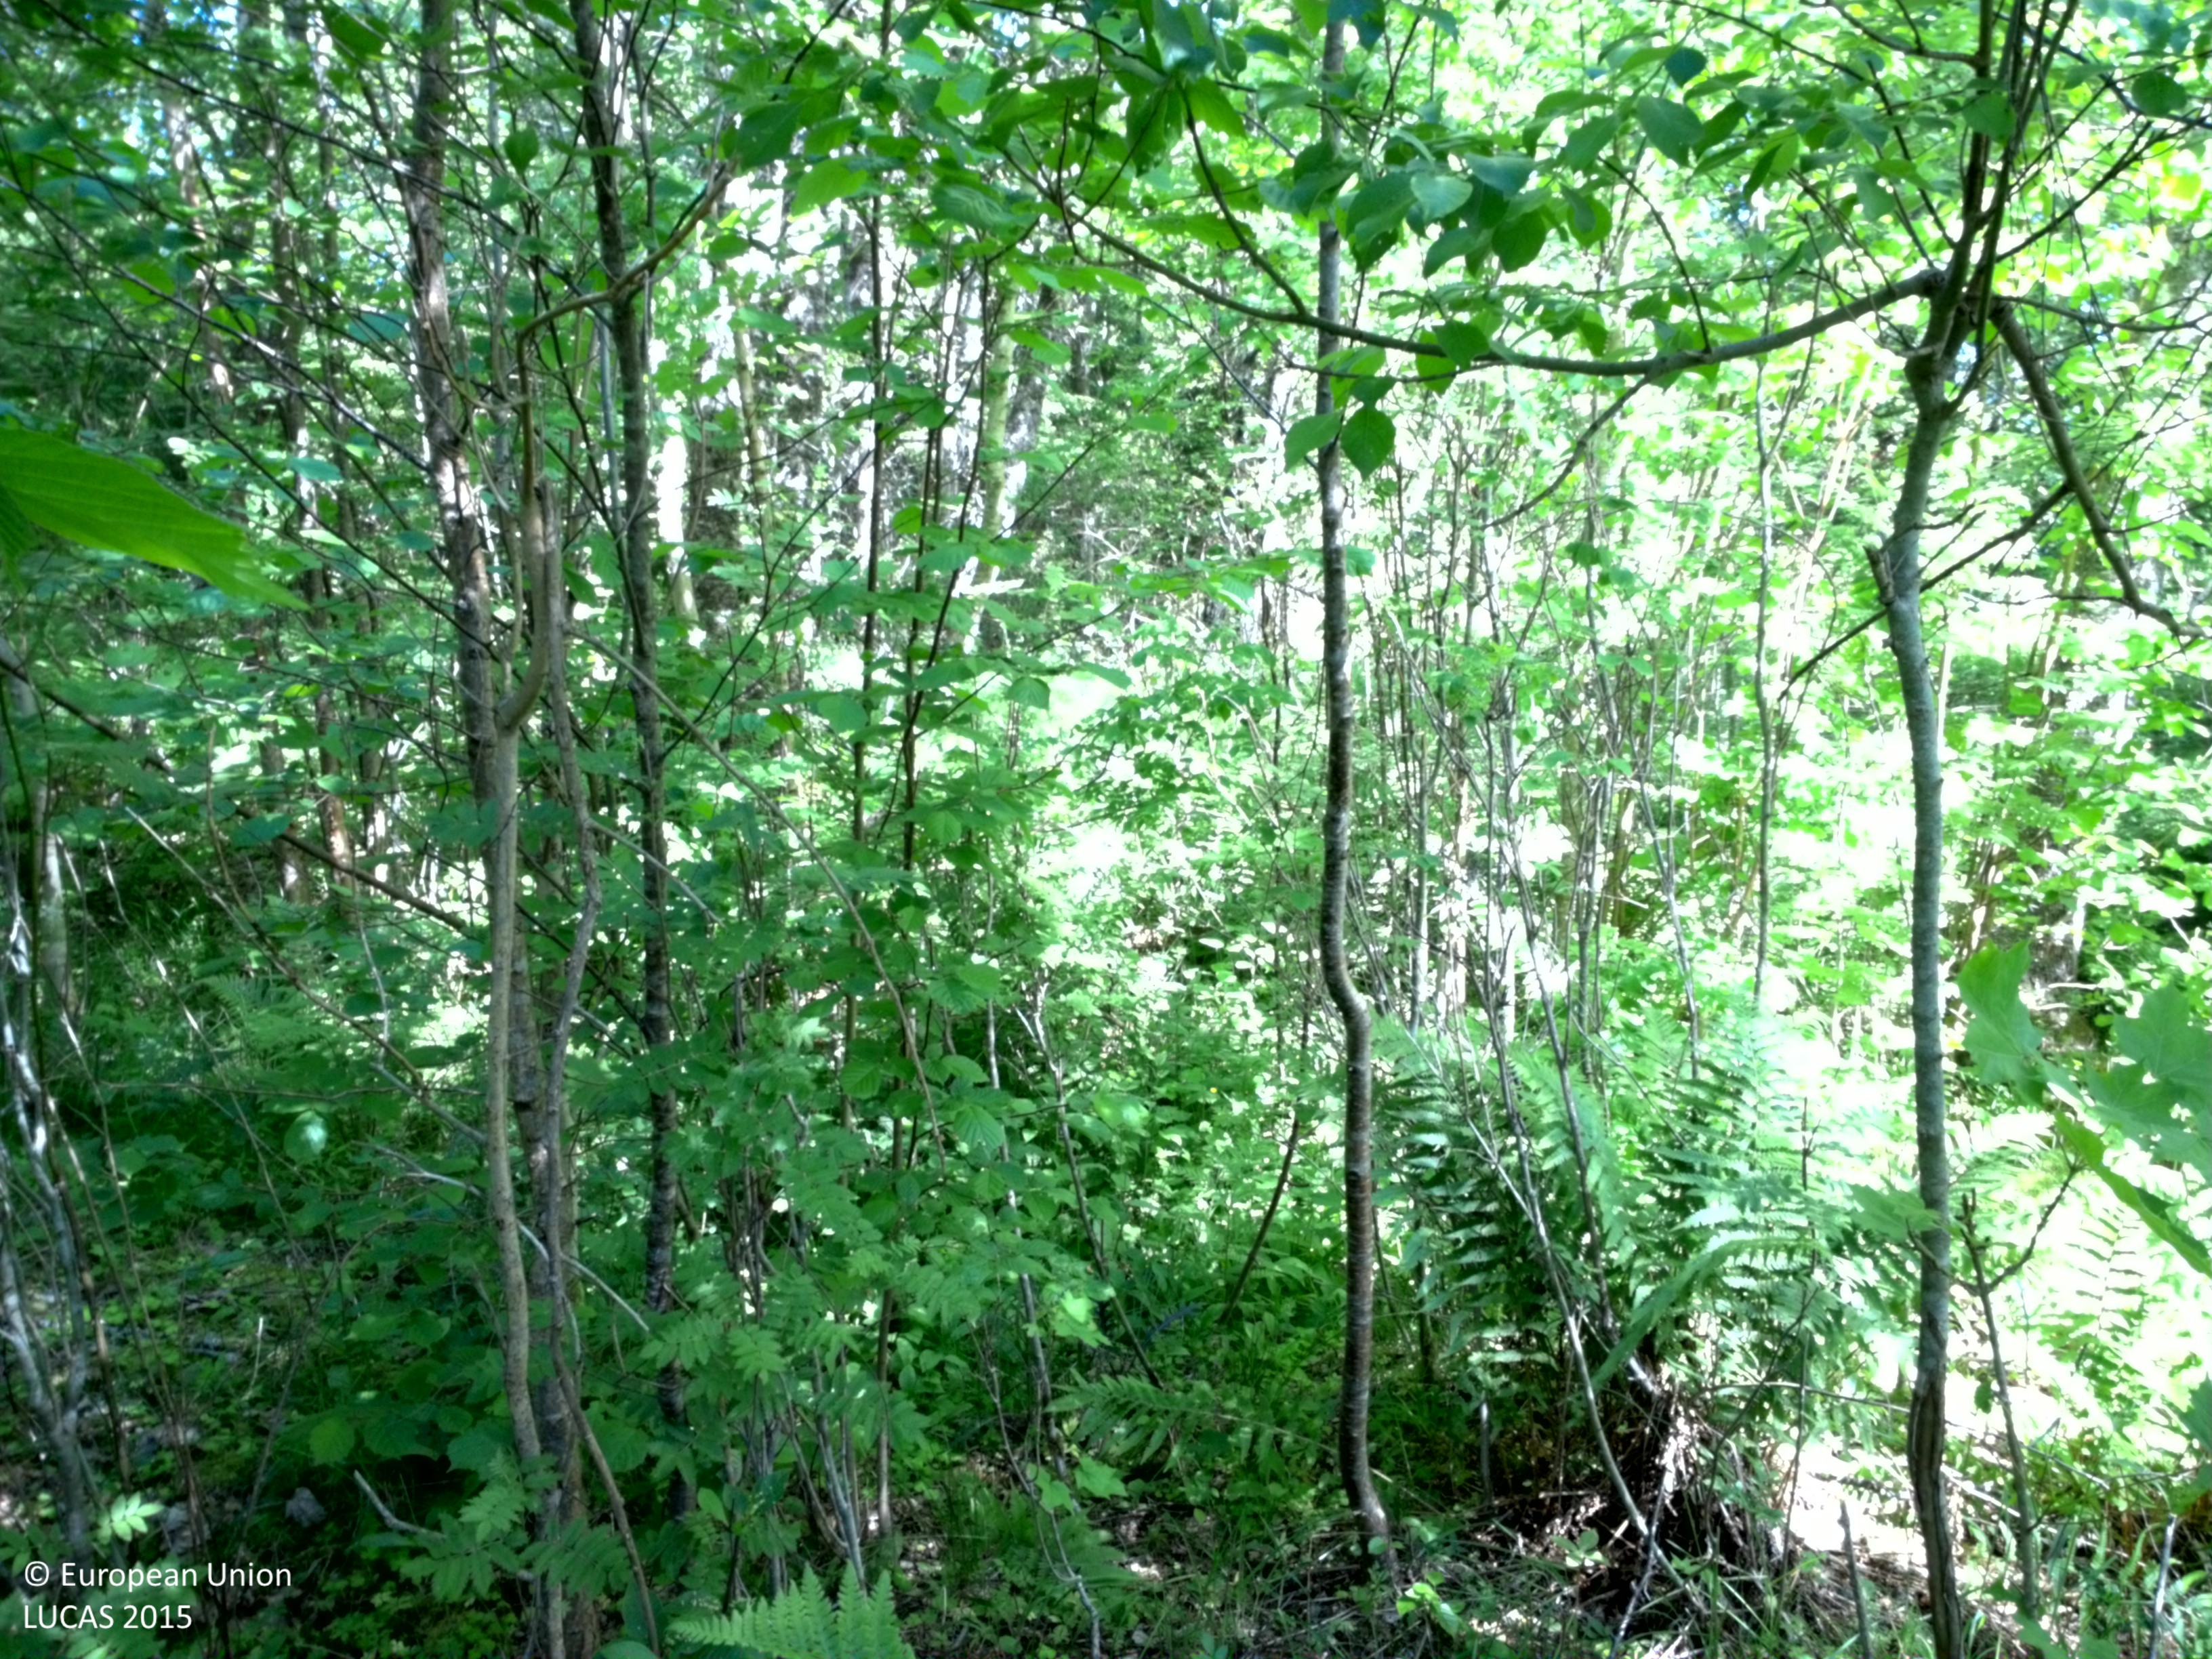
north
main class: Woodland
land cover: Broadleaved woodland
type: boreal forest
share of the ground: > 75 %
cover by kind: broadleaved forest trees 80 %, coniferous forest trees 10 %, herbaceous plants 10 %
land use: Forestry
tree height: > 5 m
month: June
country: SE
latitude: 58.6311
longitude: 14.4885
